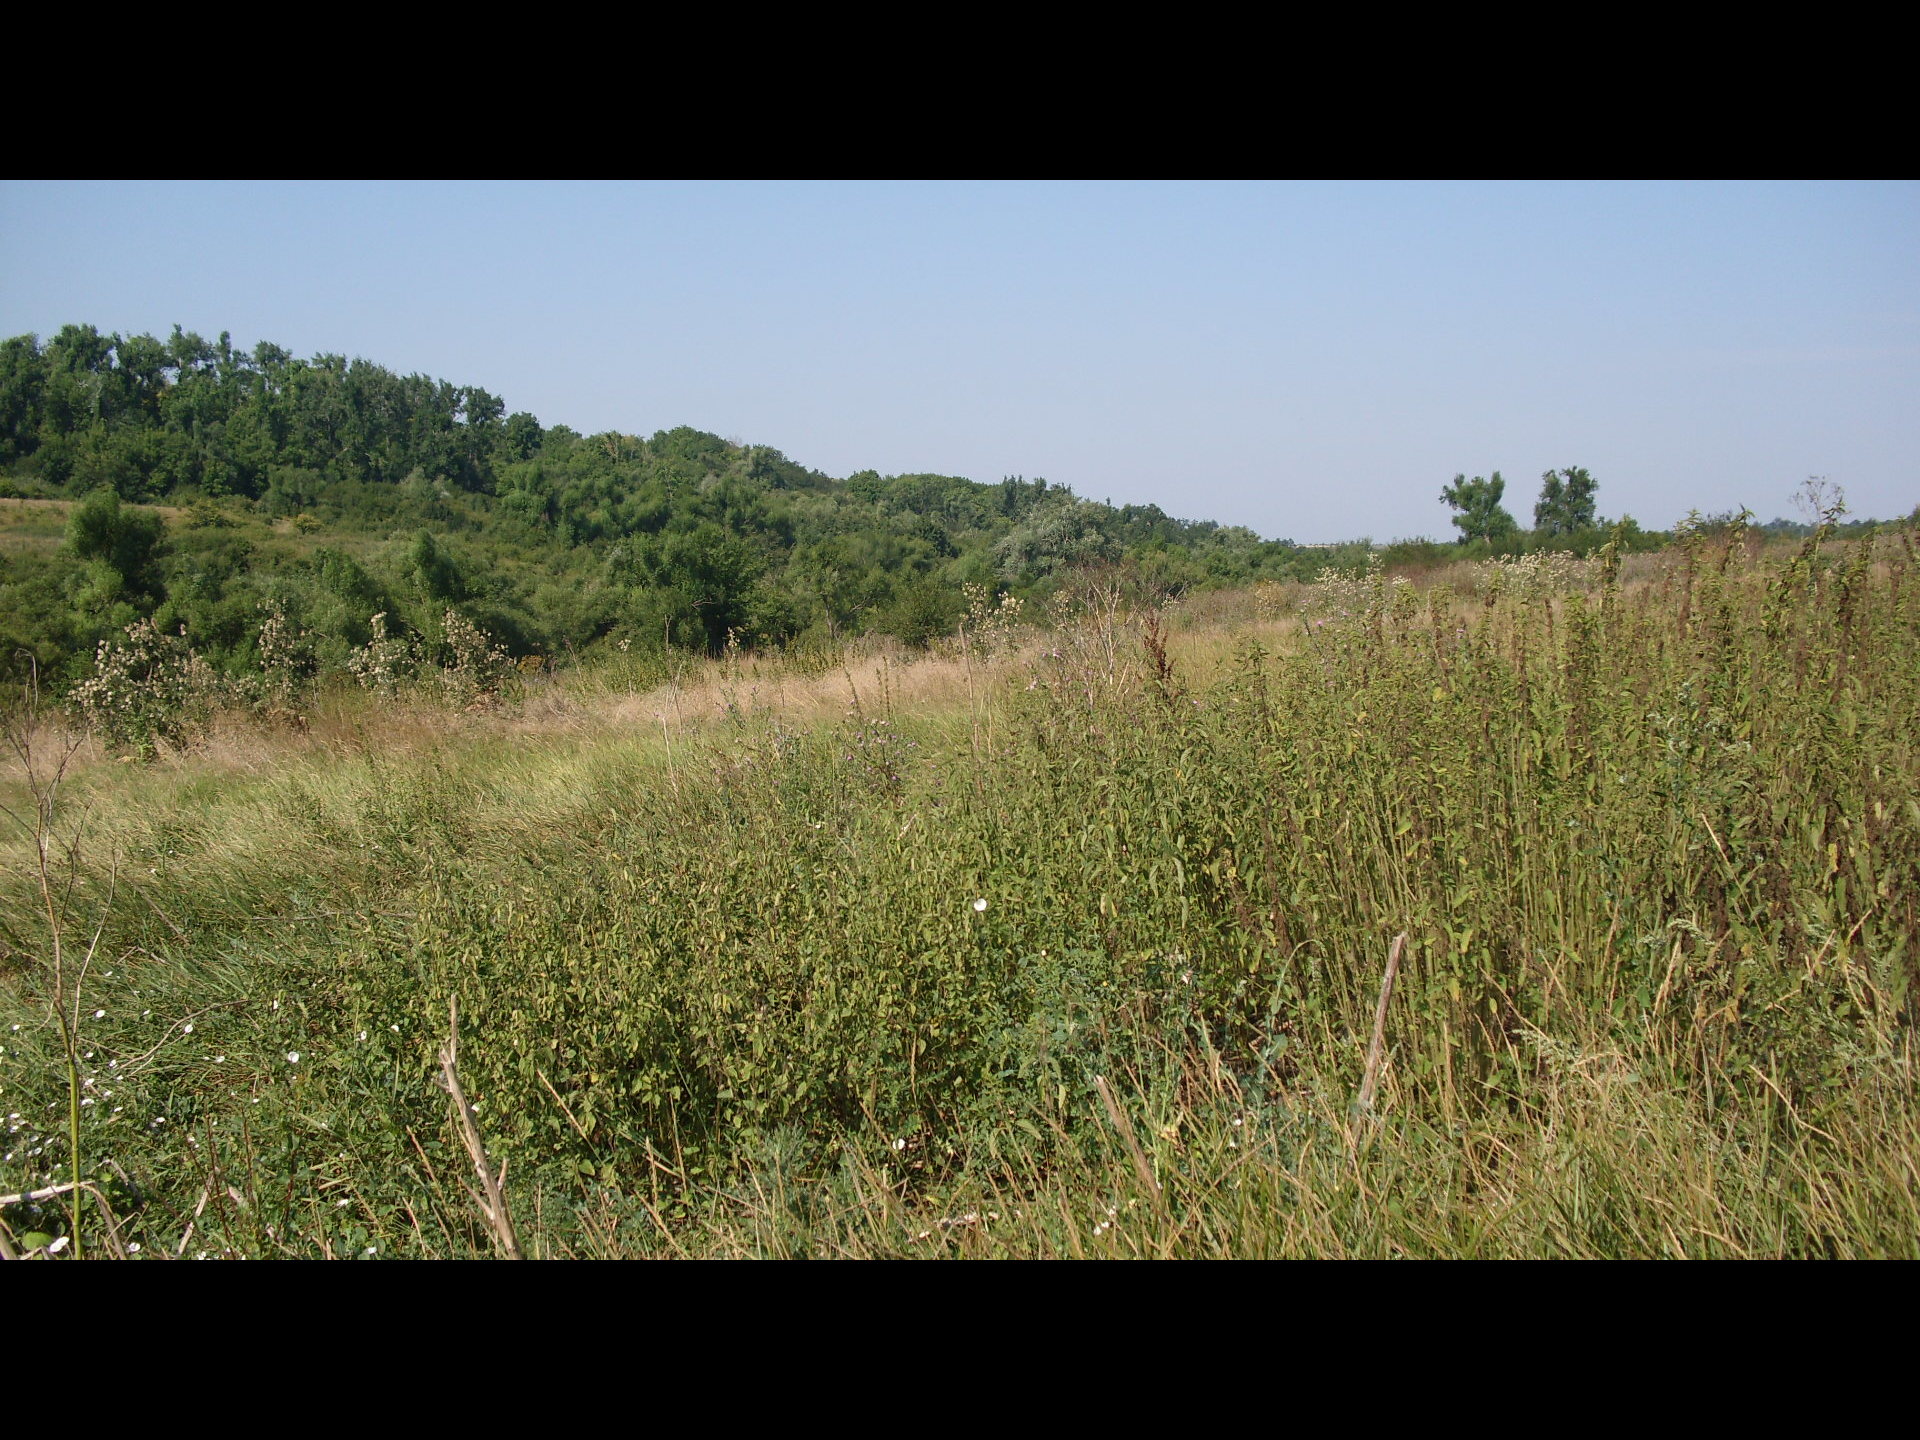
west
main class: Grassland
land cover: Grassland without tree/shrub cover
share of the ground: > 75 %
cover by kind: herbaceous plants 100 %
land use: Agriculture (excluding fallow land and kitchen gardens)
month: July
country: BG
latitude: 43.8305
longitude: 22.6320
